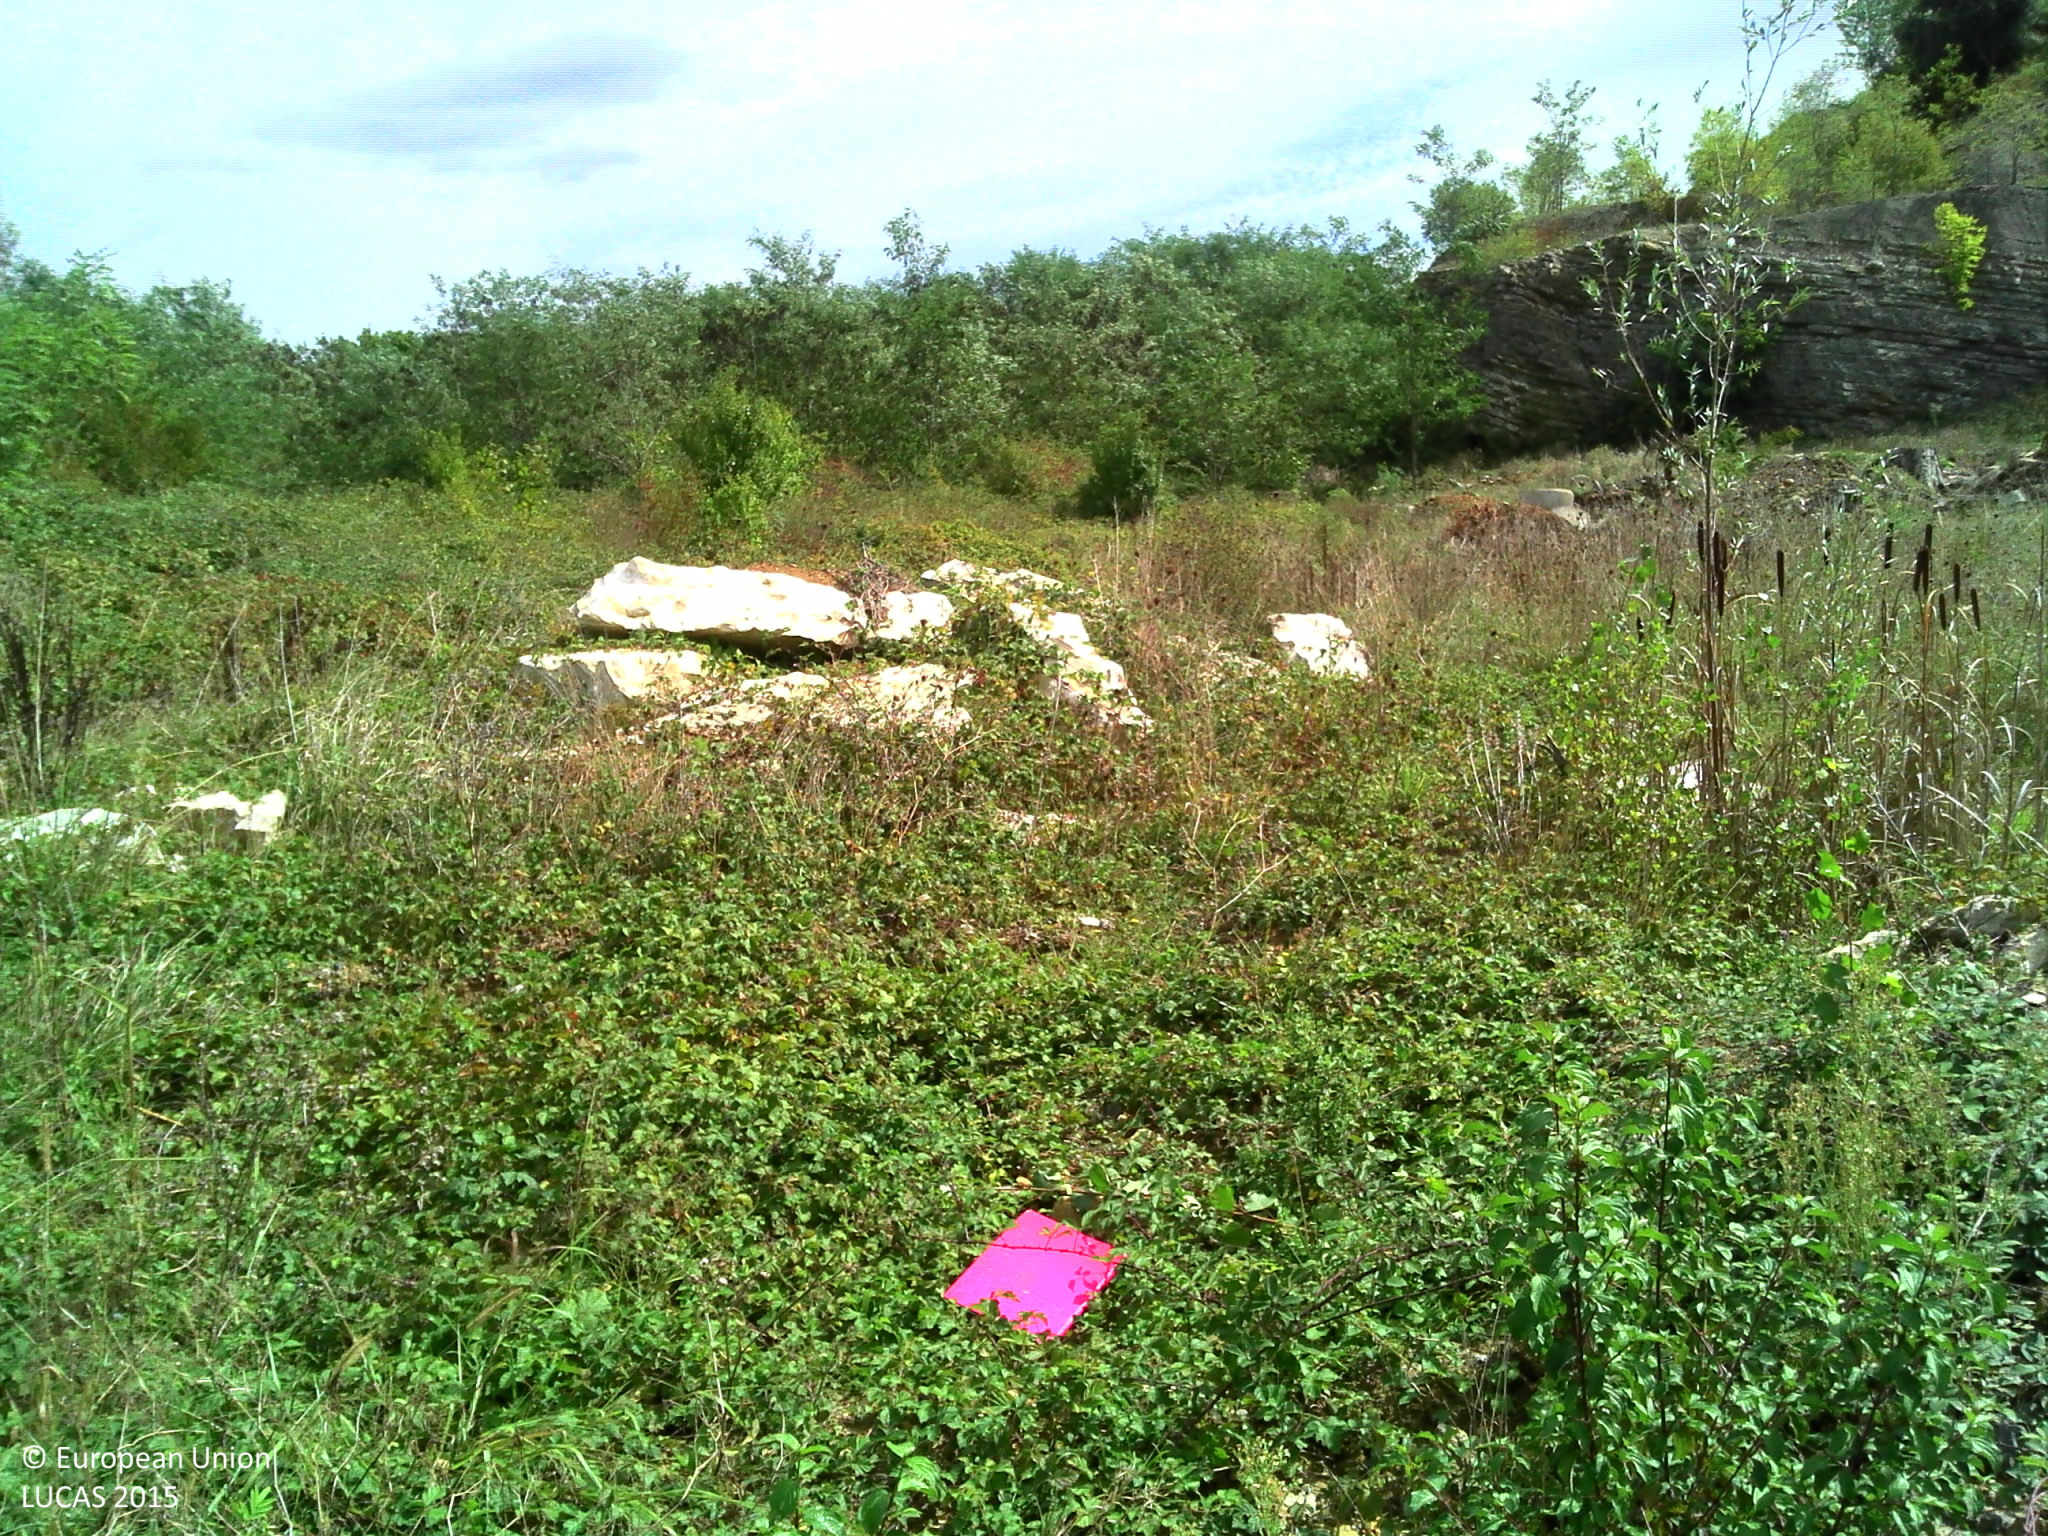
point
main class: Shrubland
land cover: Shrubland with sparse tree cover
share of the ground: > 75 %
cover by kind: shrubs 40 %, unconsolidated bare surface 30 %, herbaceous plants 20 %, broadleaved forest trees 5 %, consolidated bare surface 5 %
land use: Abandoned areas
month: September
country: FR
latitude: 43.4273
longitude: -0.7453
